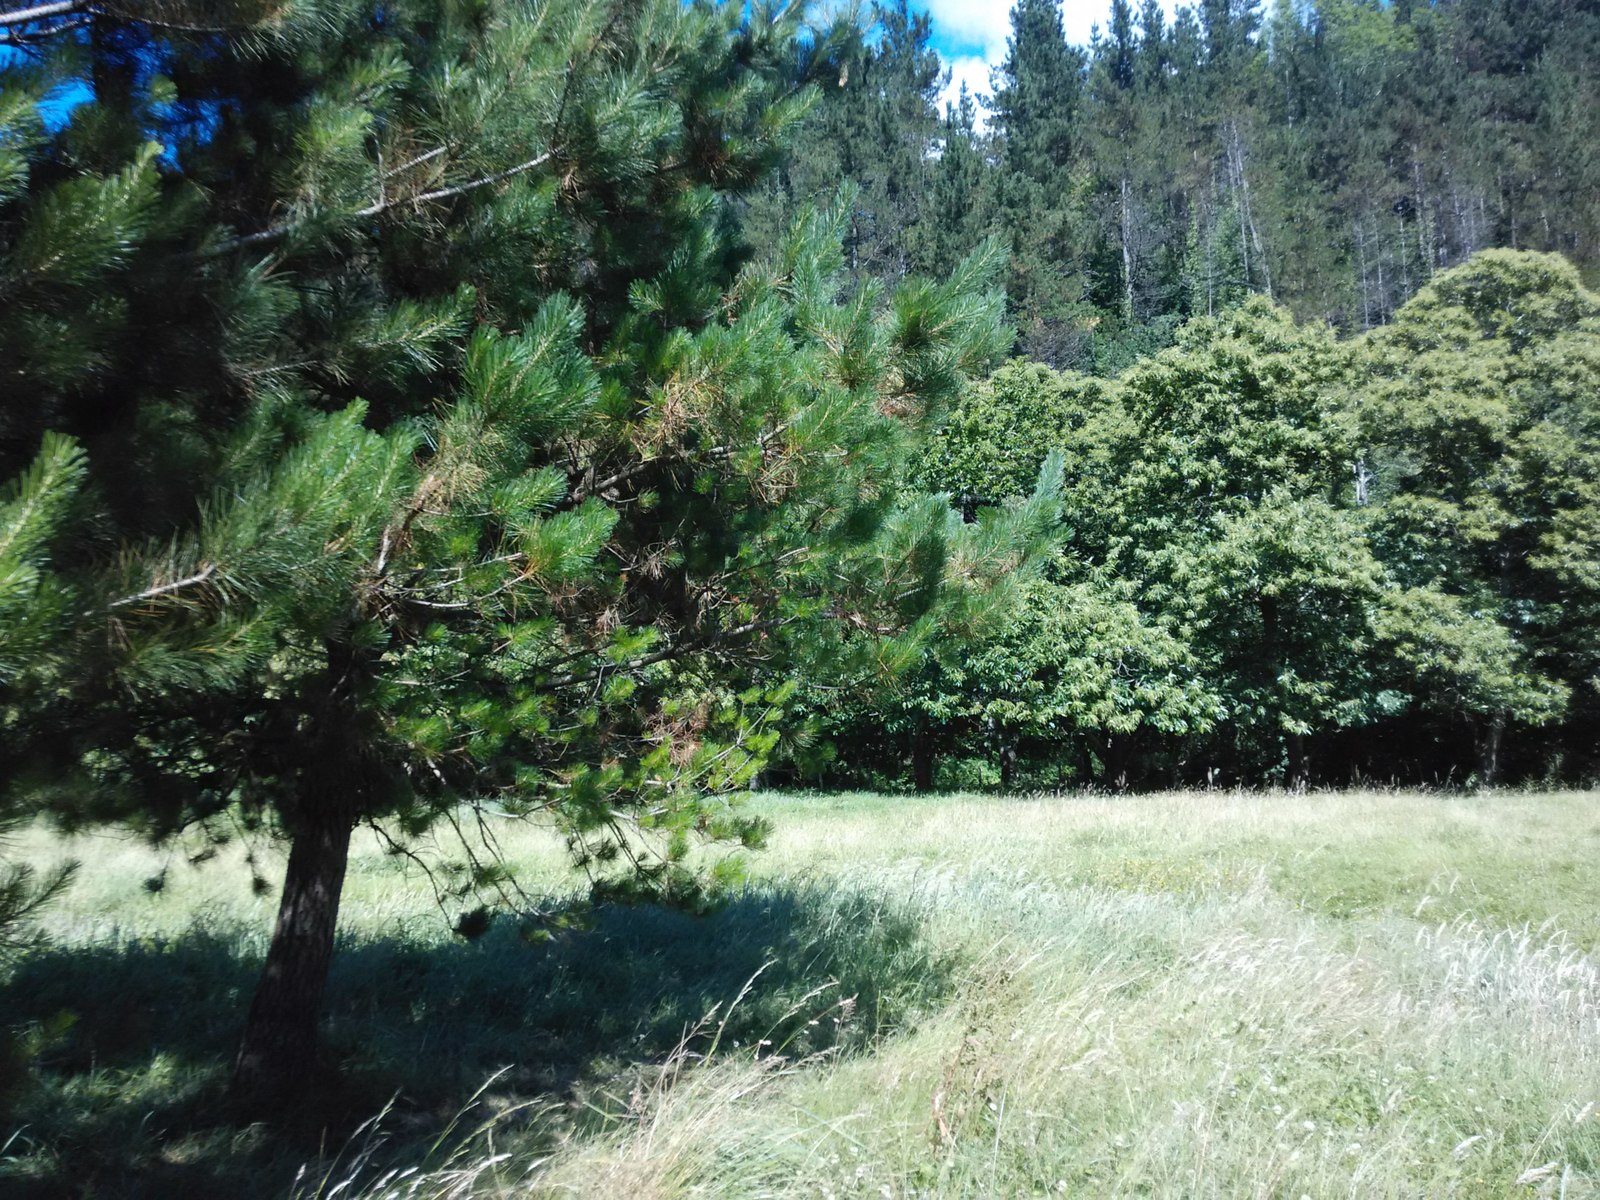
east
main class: Grassland
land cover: Grassland with sparse tree/shrub cover
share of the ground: > 75 %
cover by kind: herbaceous plants 95 %, coniferous forest trees 5 %
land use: Agriculture (excluding fallow land and kitchen gardens)
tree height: > 5 m
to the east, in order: Grassland with sparse tree/shrub cover; Grassland without tree/shrub cover; Nuts trees; Fences; Rivers and streams; Pine dominated coniferous woodland; Paved roads, cycling and walking lanes; Pine dominated coniferous woodland; Broadleaved woodland
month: June
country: ES
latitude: 43.2917
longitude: -2.5641
